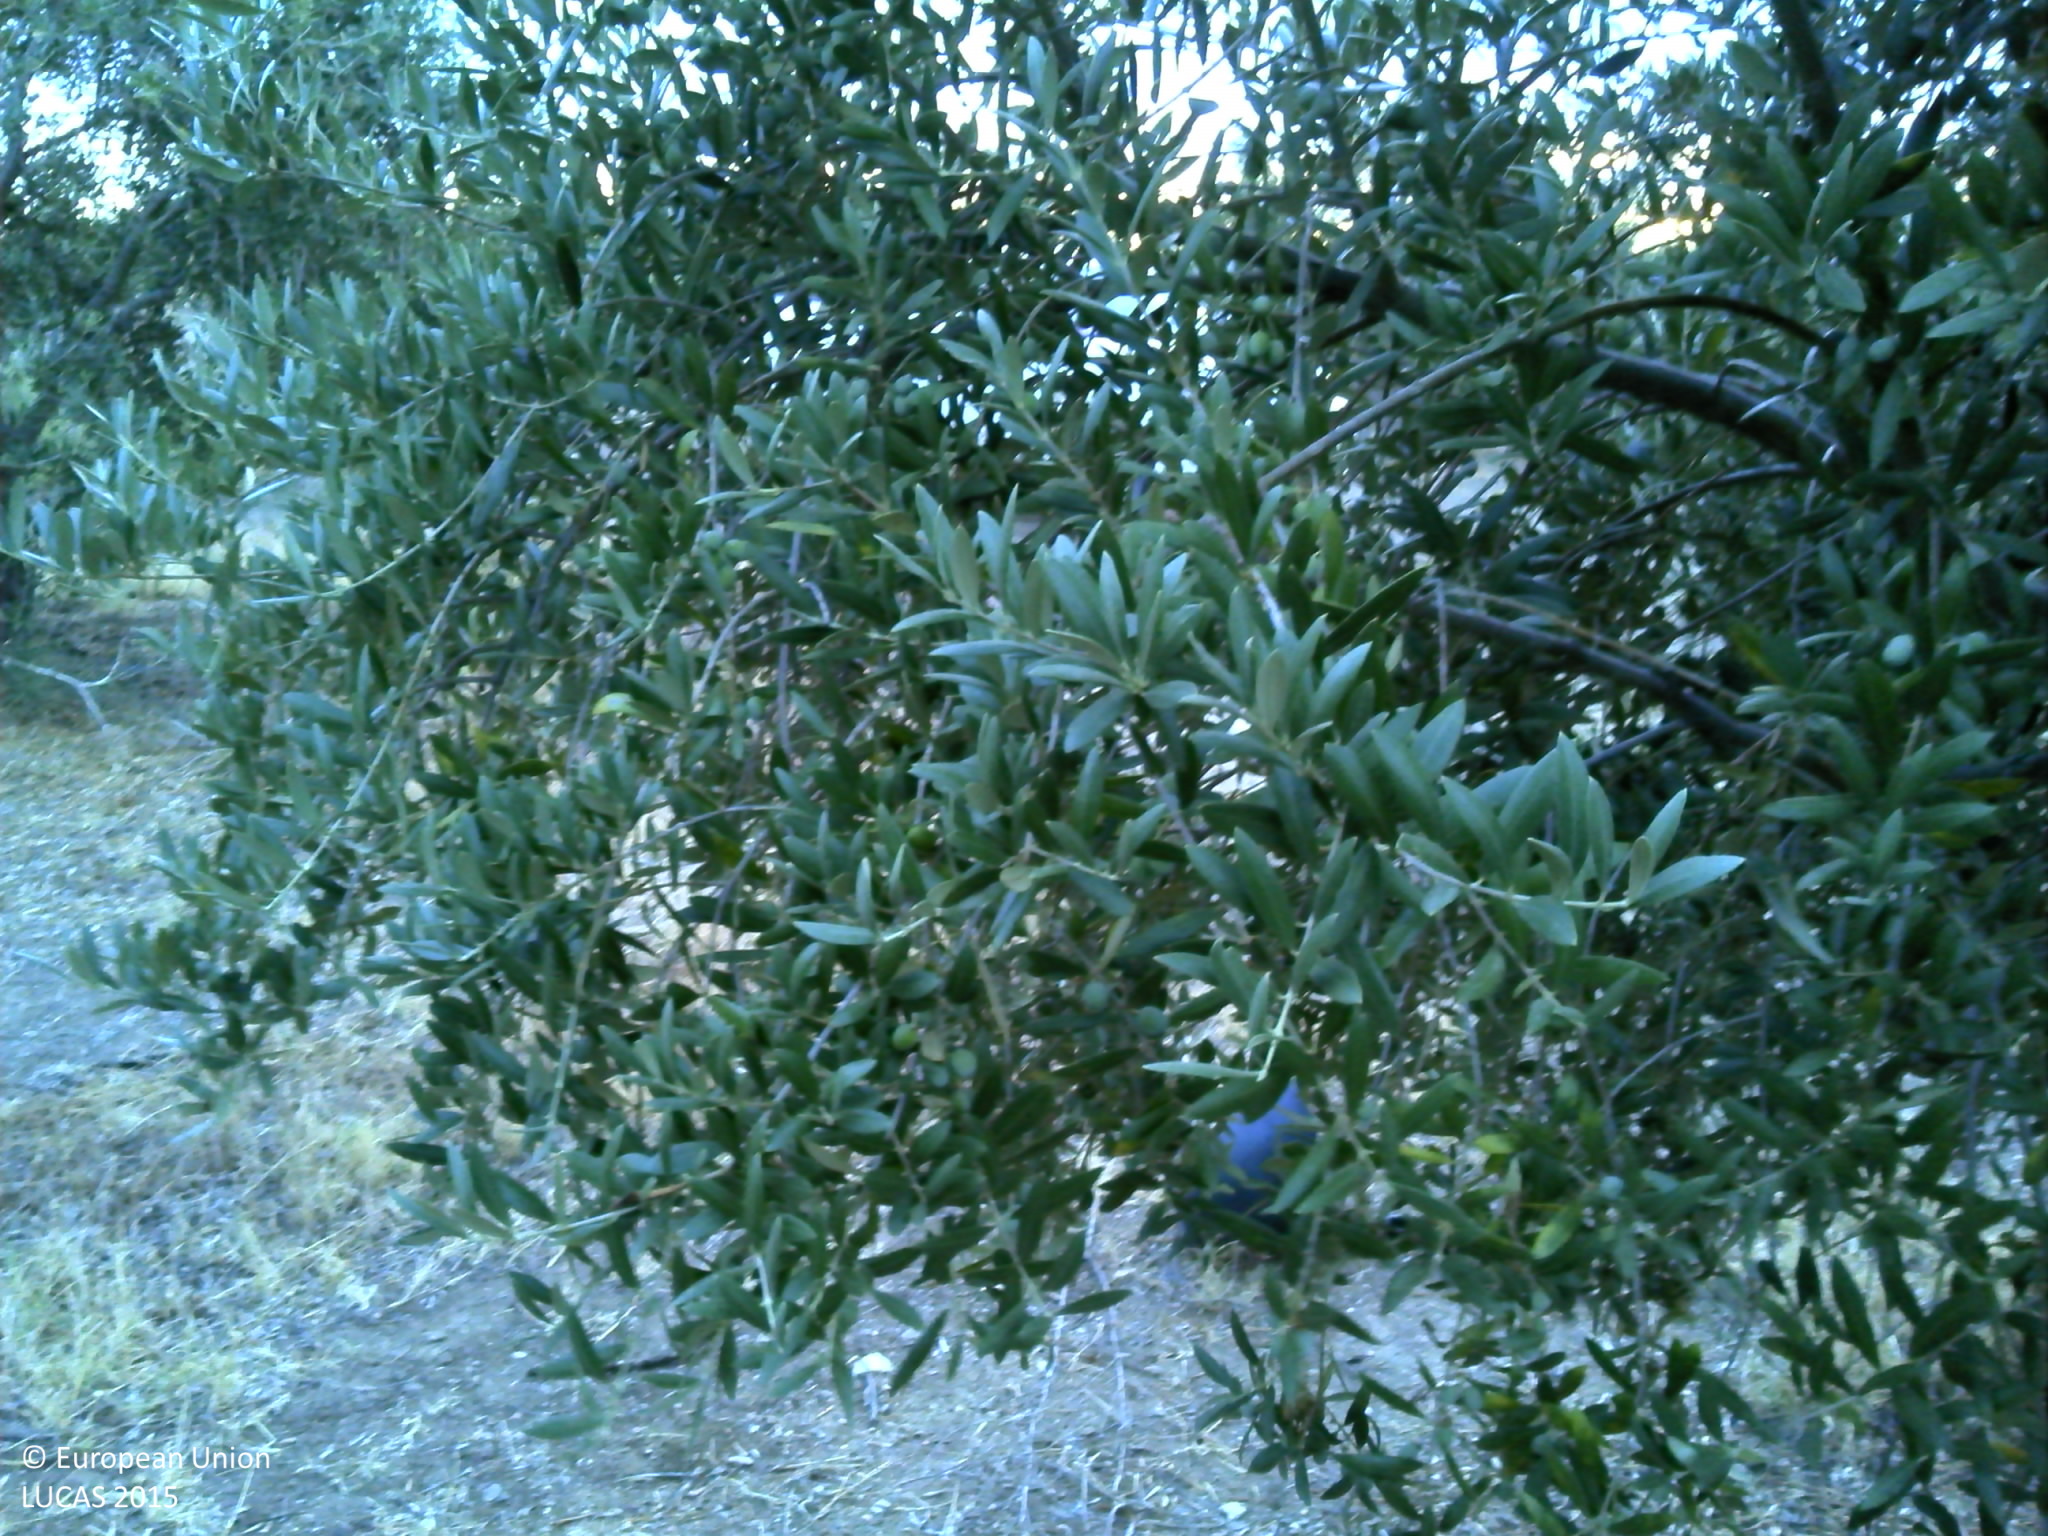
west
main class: Cropland
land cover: Olive groves
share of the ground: > 75 %
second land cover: Grassland without tree/shrub cover
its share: < 10 %
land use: Agriculture (excluding fallow land and kitchen gardens)
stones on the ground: < 10 %
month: July
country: PT
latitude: 38.0832
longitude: -7.7315
